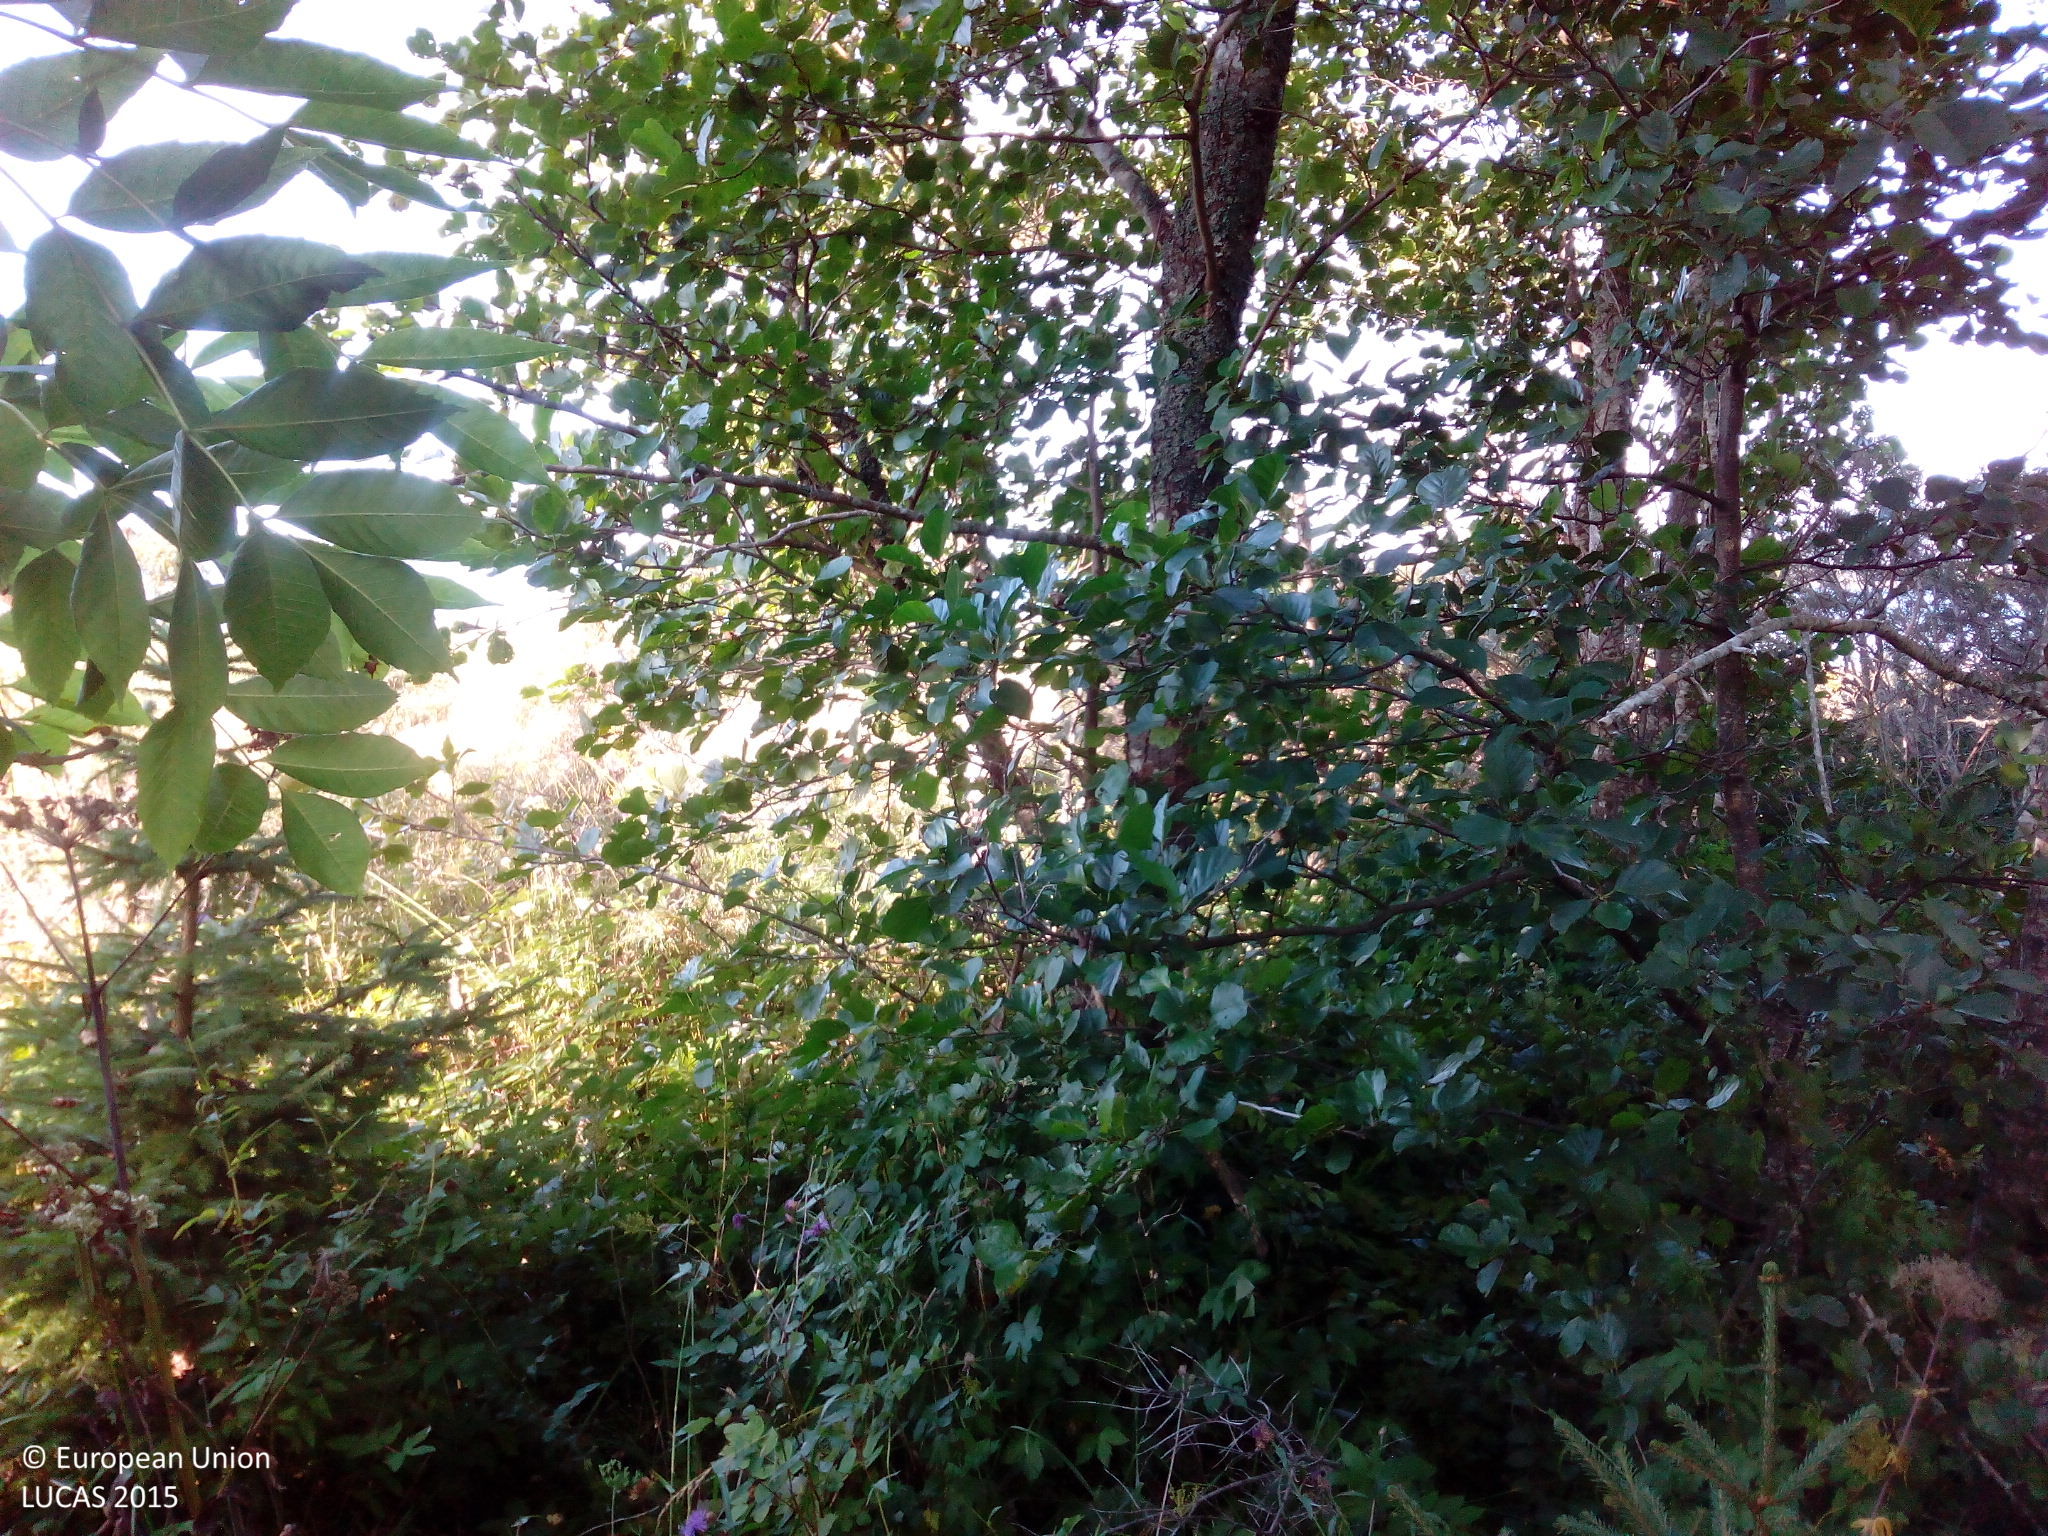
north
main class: Woodland
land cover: Broadleaved woodland
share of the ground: > 75 %
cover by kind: broadleaved forest trees 70 %, herbaceous plants 20 %, coniferous forest trees 10 %
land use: Semi-natural and natural areas not in use
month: August
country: FI
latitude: 60.2983
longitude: 19.7201
